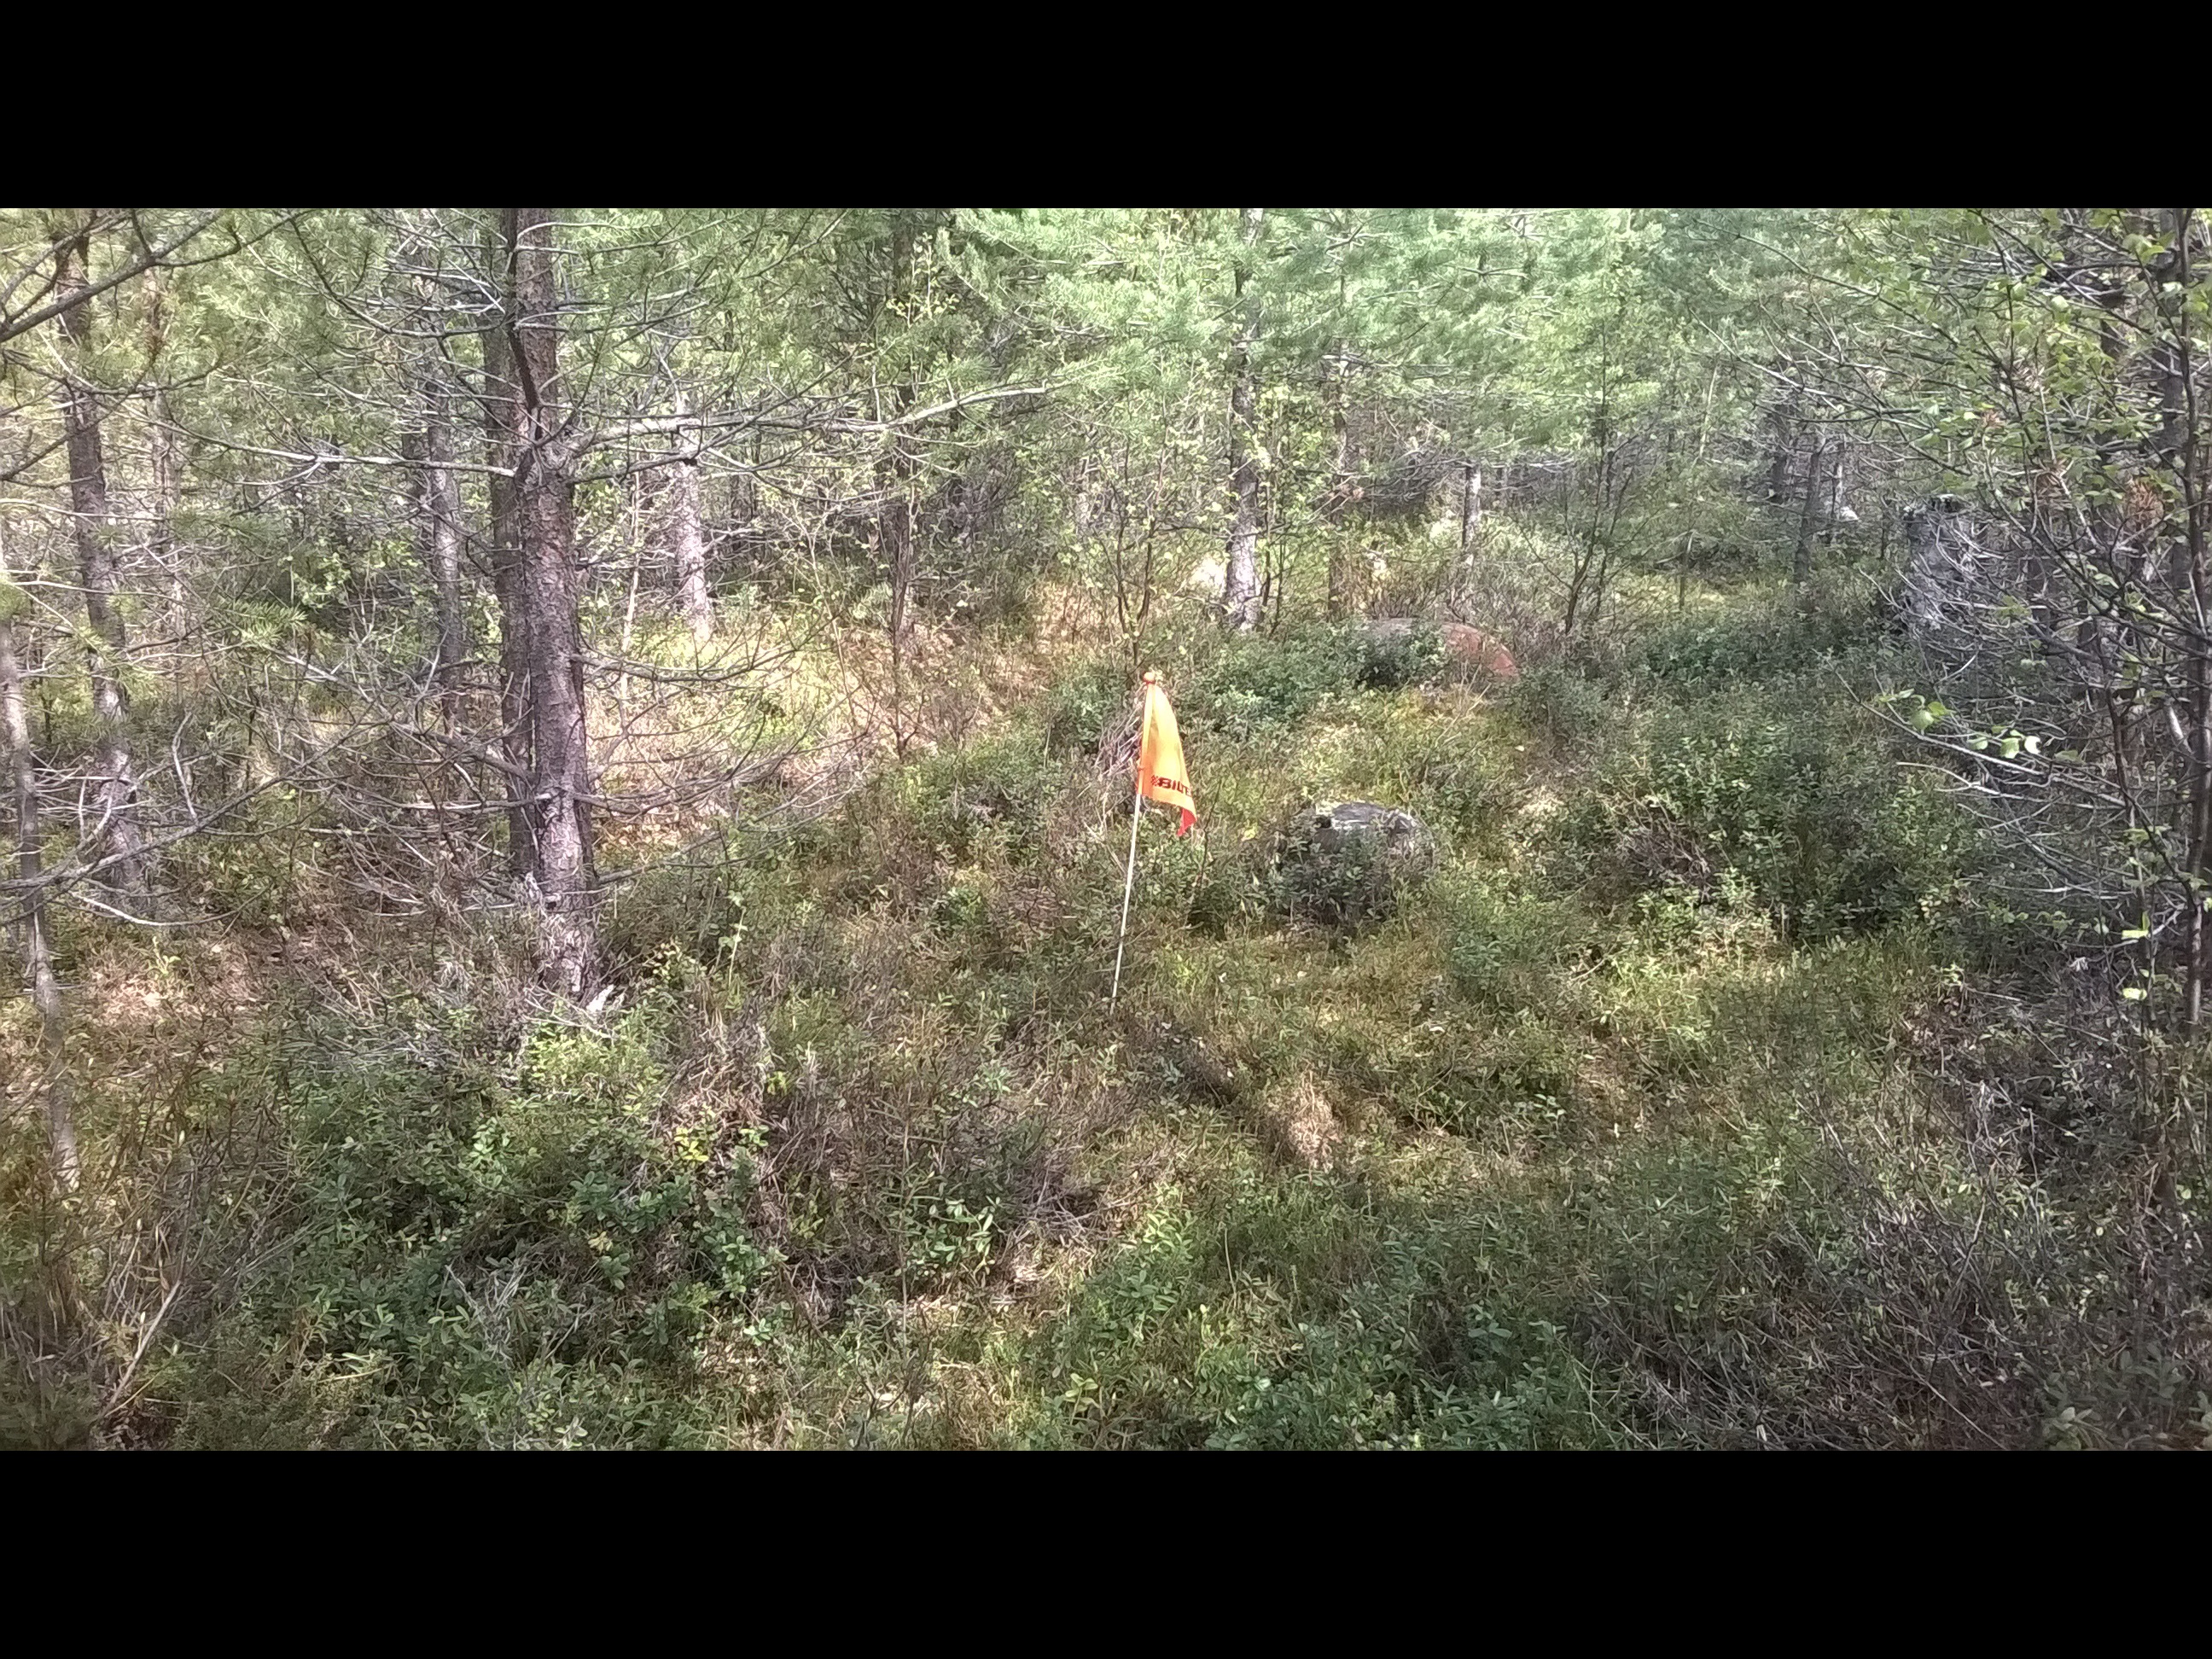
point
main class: Woodland
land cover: Pine dominated coniferous woodland
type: boreal forest
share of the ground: > 75 %
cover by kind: coniferous forest trees 90 %, broadleaved forest trees 5 %, shrubs 5 %
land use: Forestry
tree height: < 5 m
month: June
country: FI
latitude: 66.5653
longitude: 26.5591
